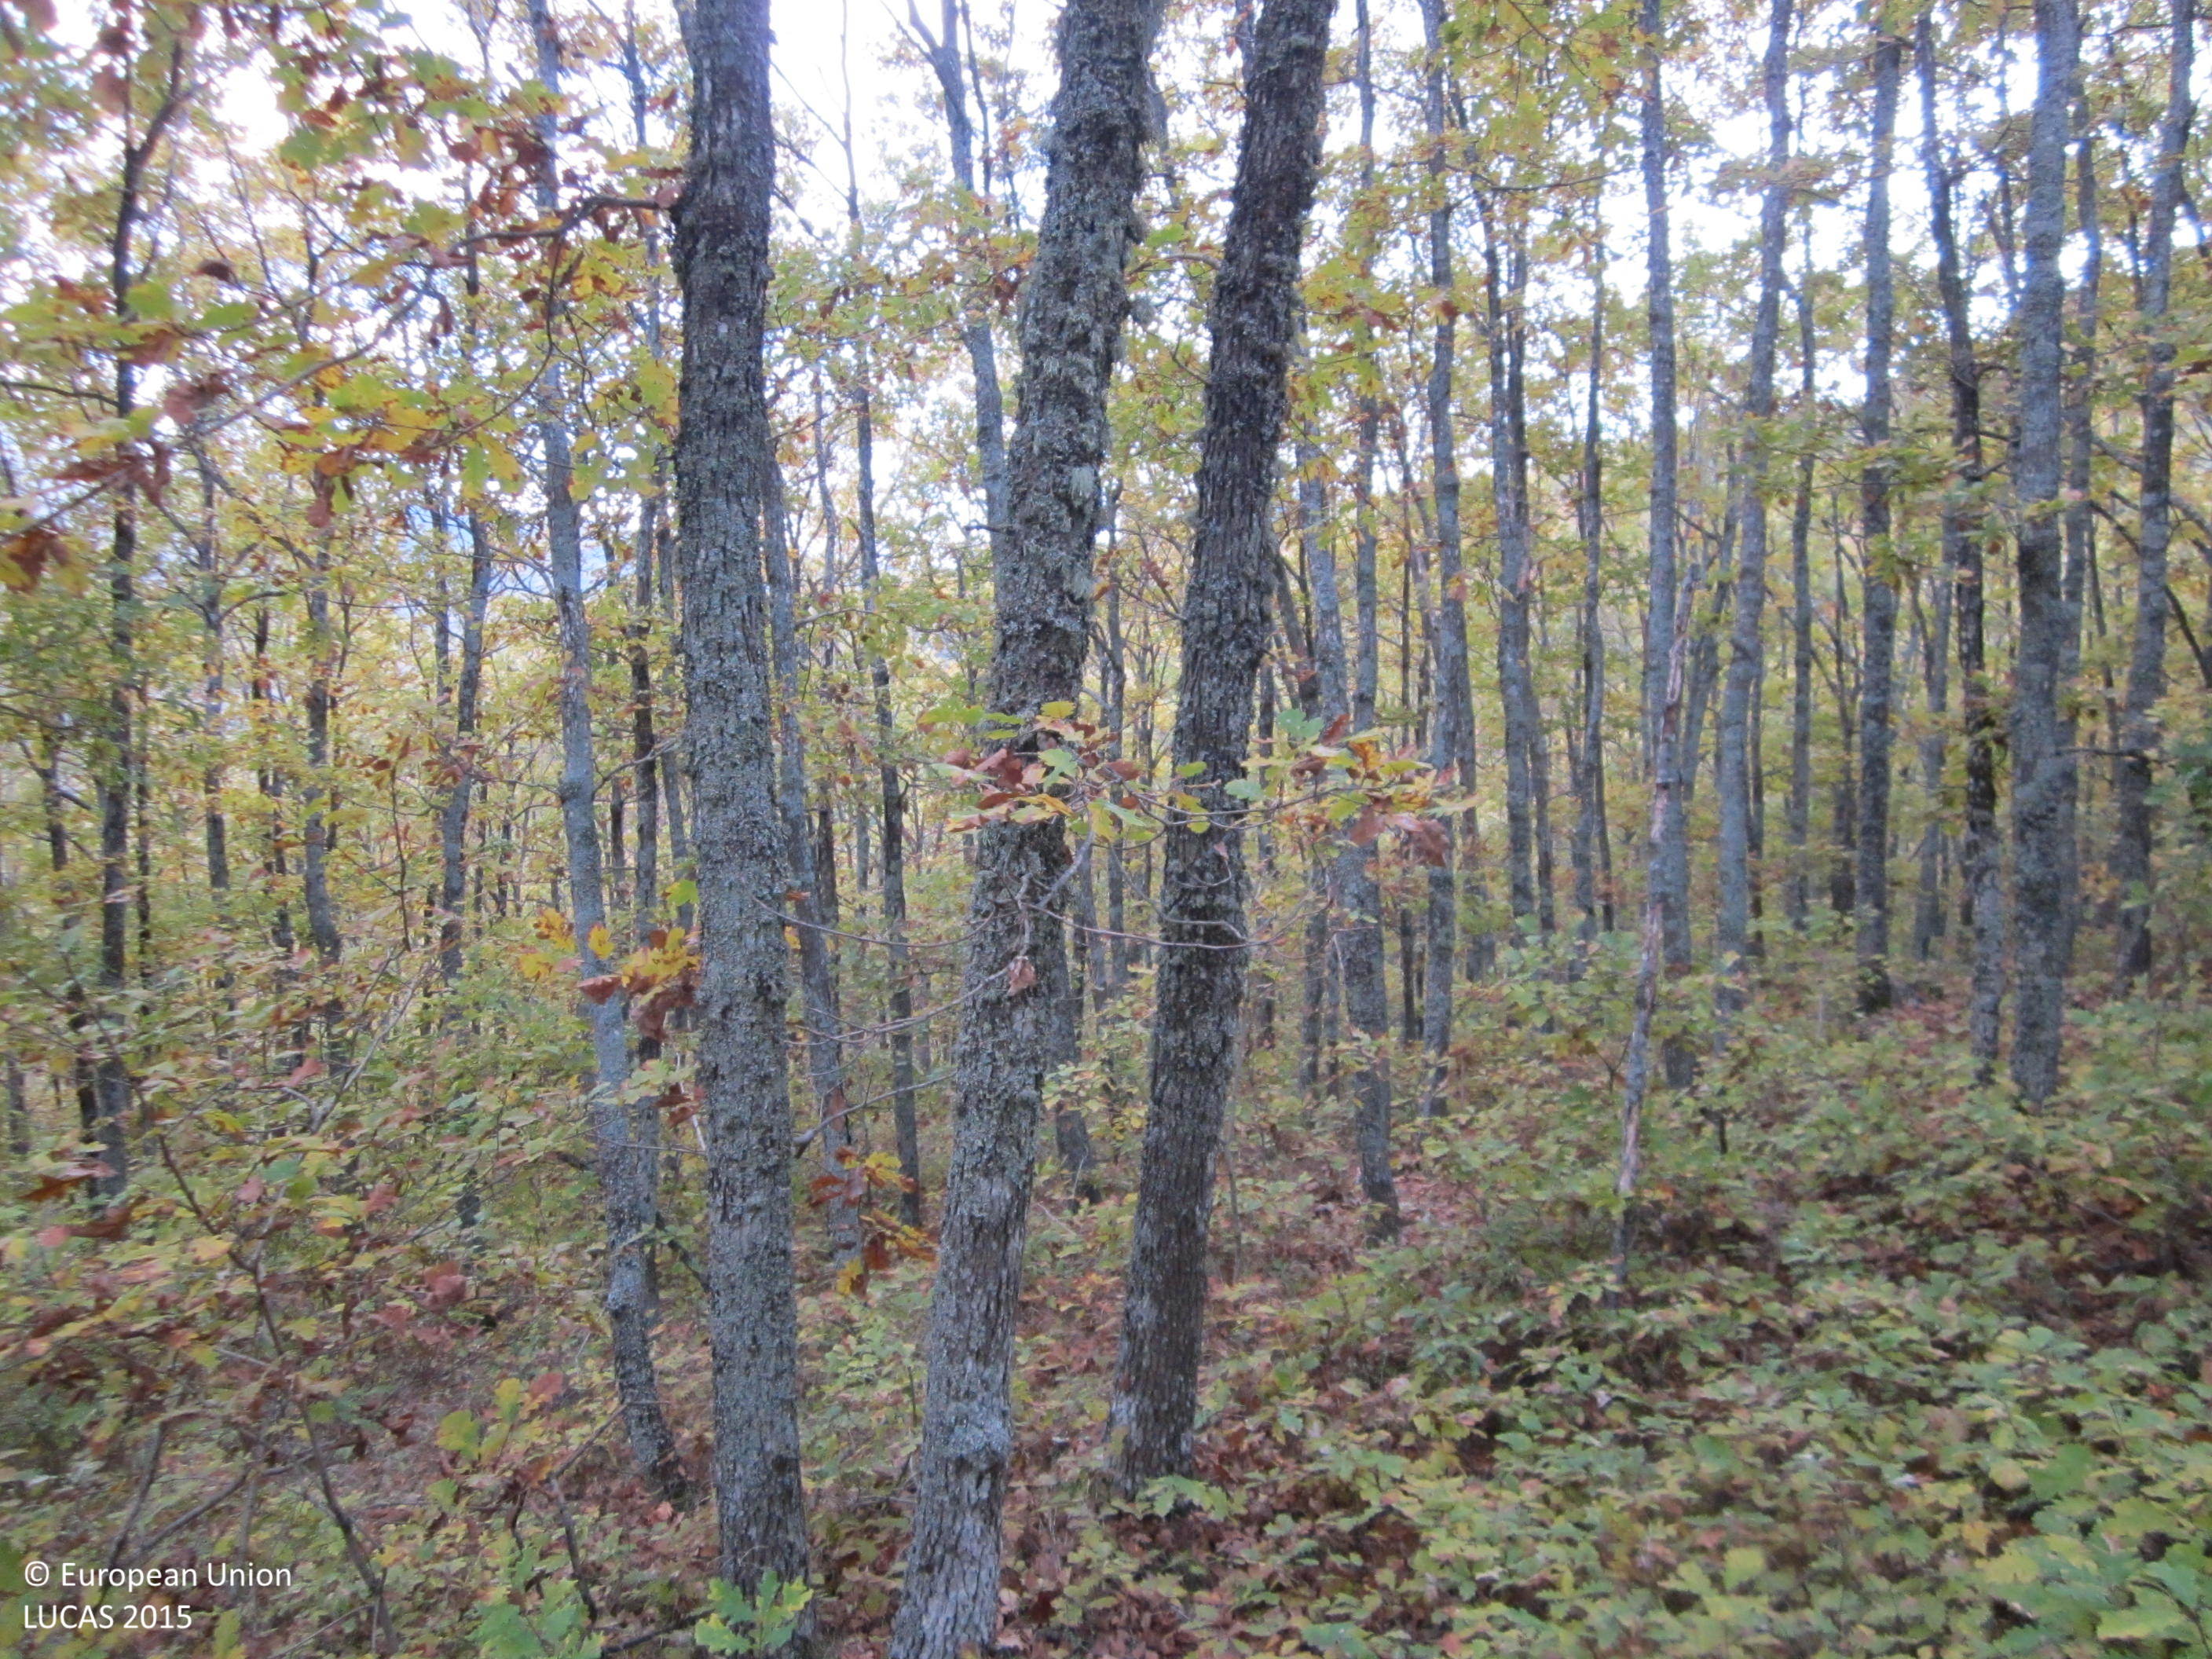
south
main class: Woodland
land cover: Broadleaved woodland
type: acidophilous oak and oak-birch forest
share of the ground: > 75 %
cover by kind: broadleaved forest trees 90 %, shrubs 5 %, herbaceous plants 5 %
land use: Forestry
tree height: > 5 m
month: November
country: BG
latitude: 41.3632
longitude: 25.8301
